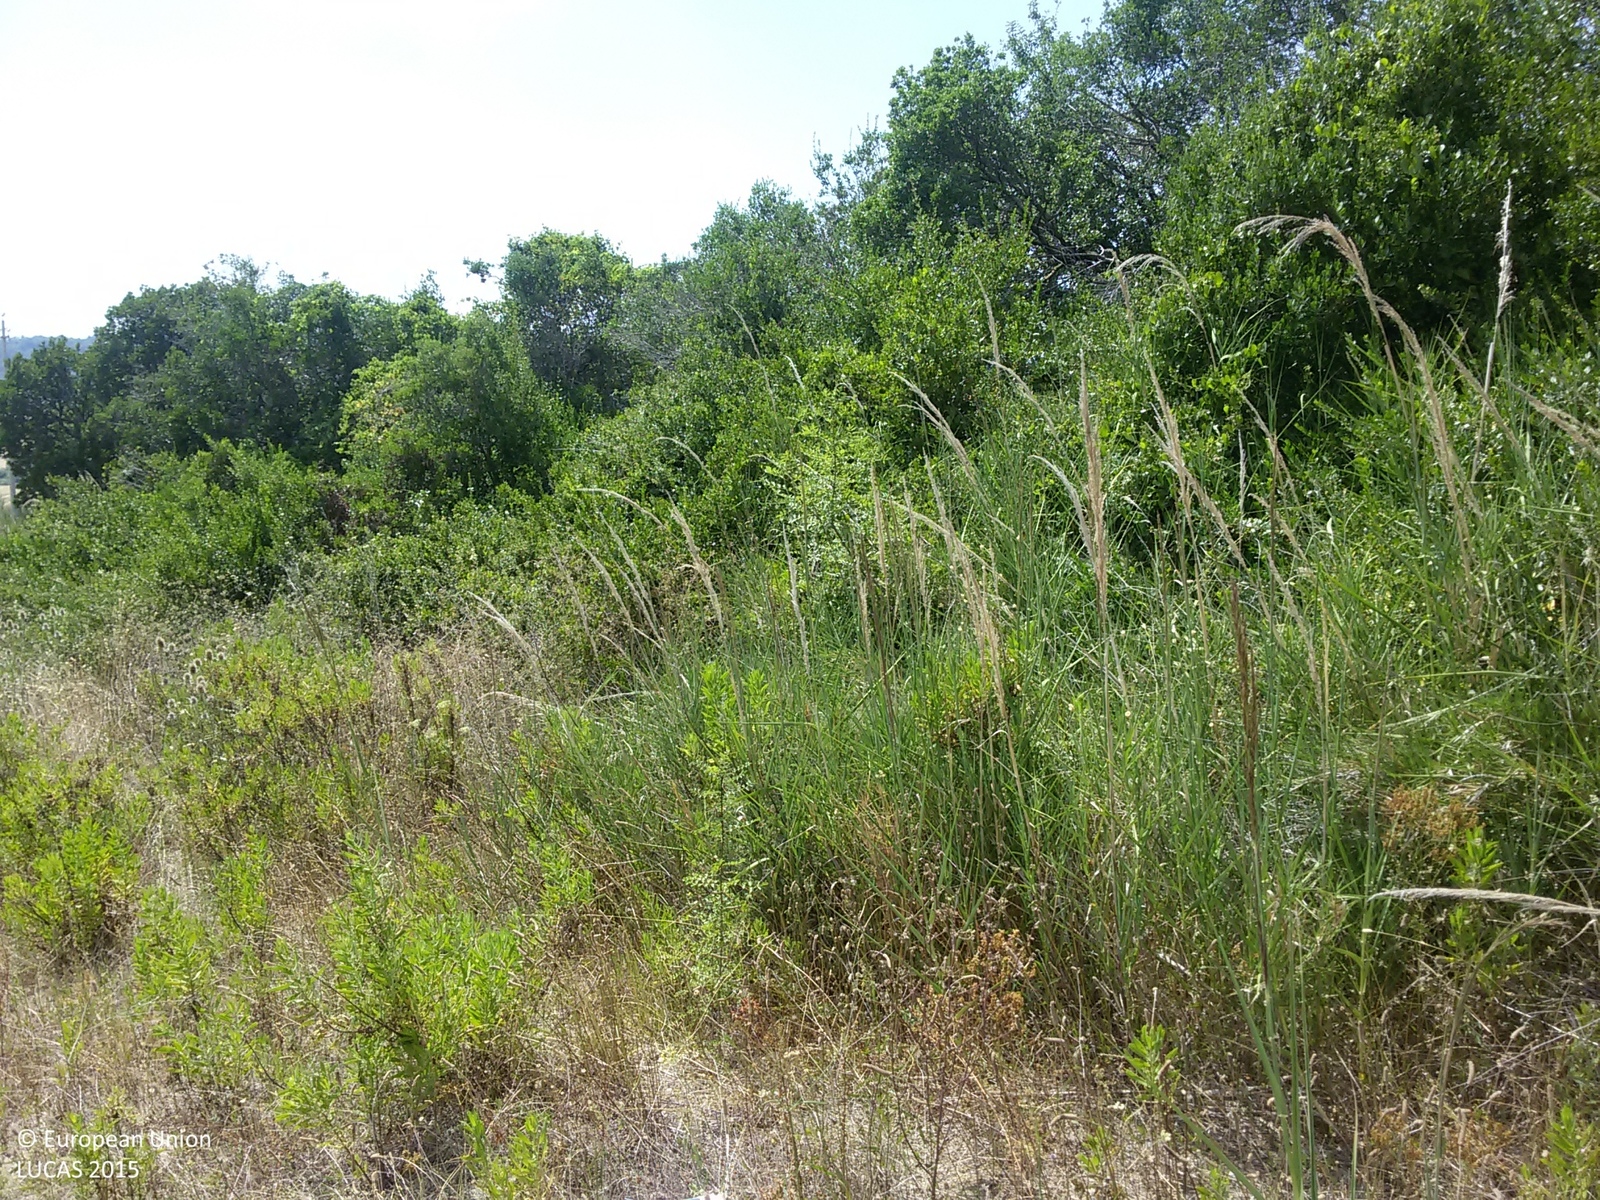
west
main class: Grassland
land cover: Grassland without tree/shrub cover
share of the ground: 50 - 75 %
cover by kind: herbaceous plants 90 %, consolidated bare surface 5 %, unconsolidated bare surface 5 %
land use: Agriculture (excluding fallow land and kitchen gardens)
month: July
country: IT
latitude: 42.7156
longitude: 11.4726
